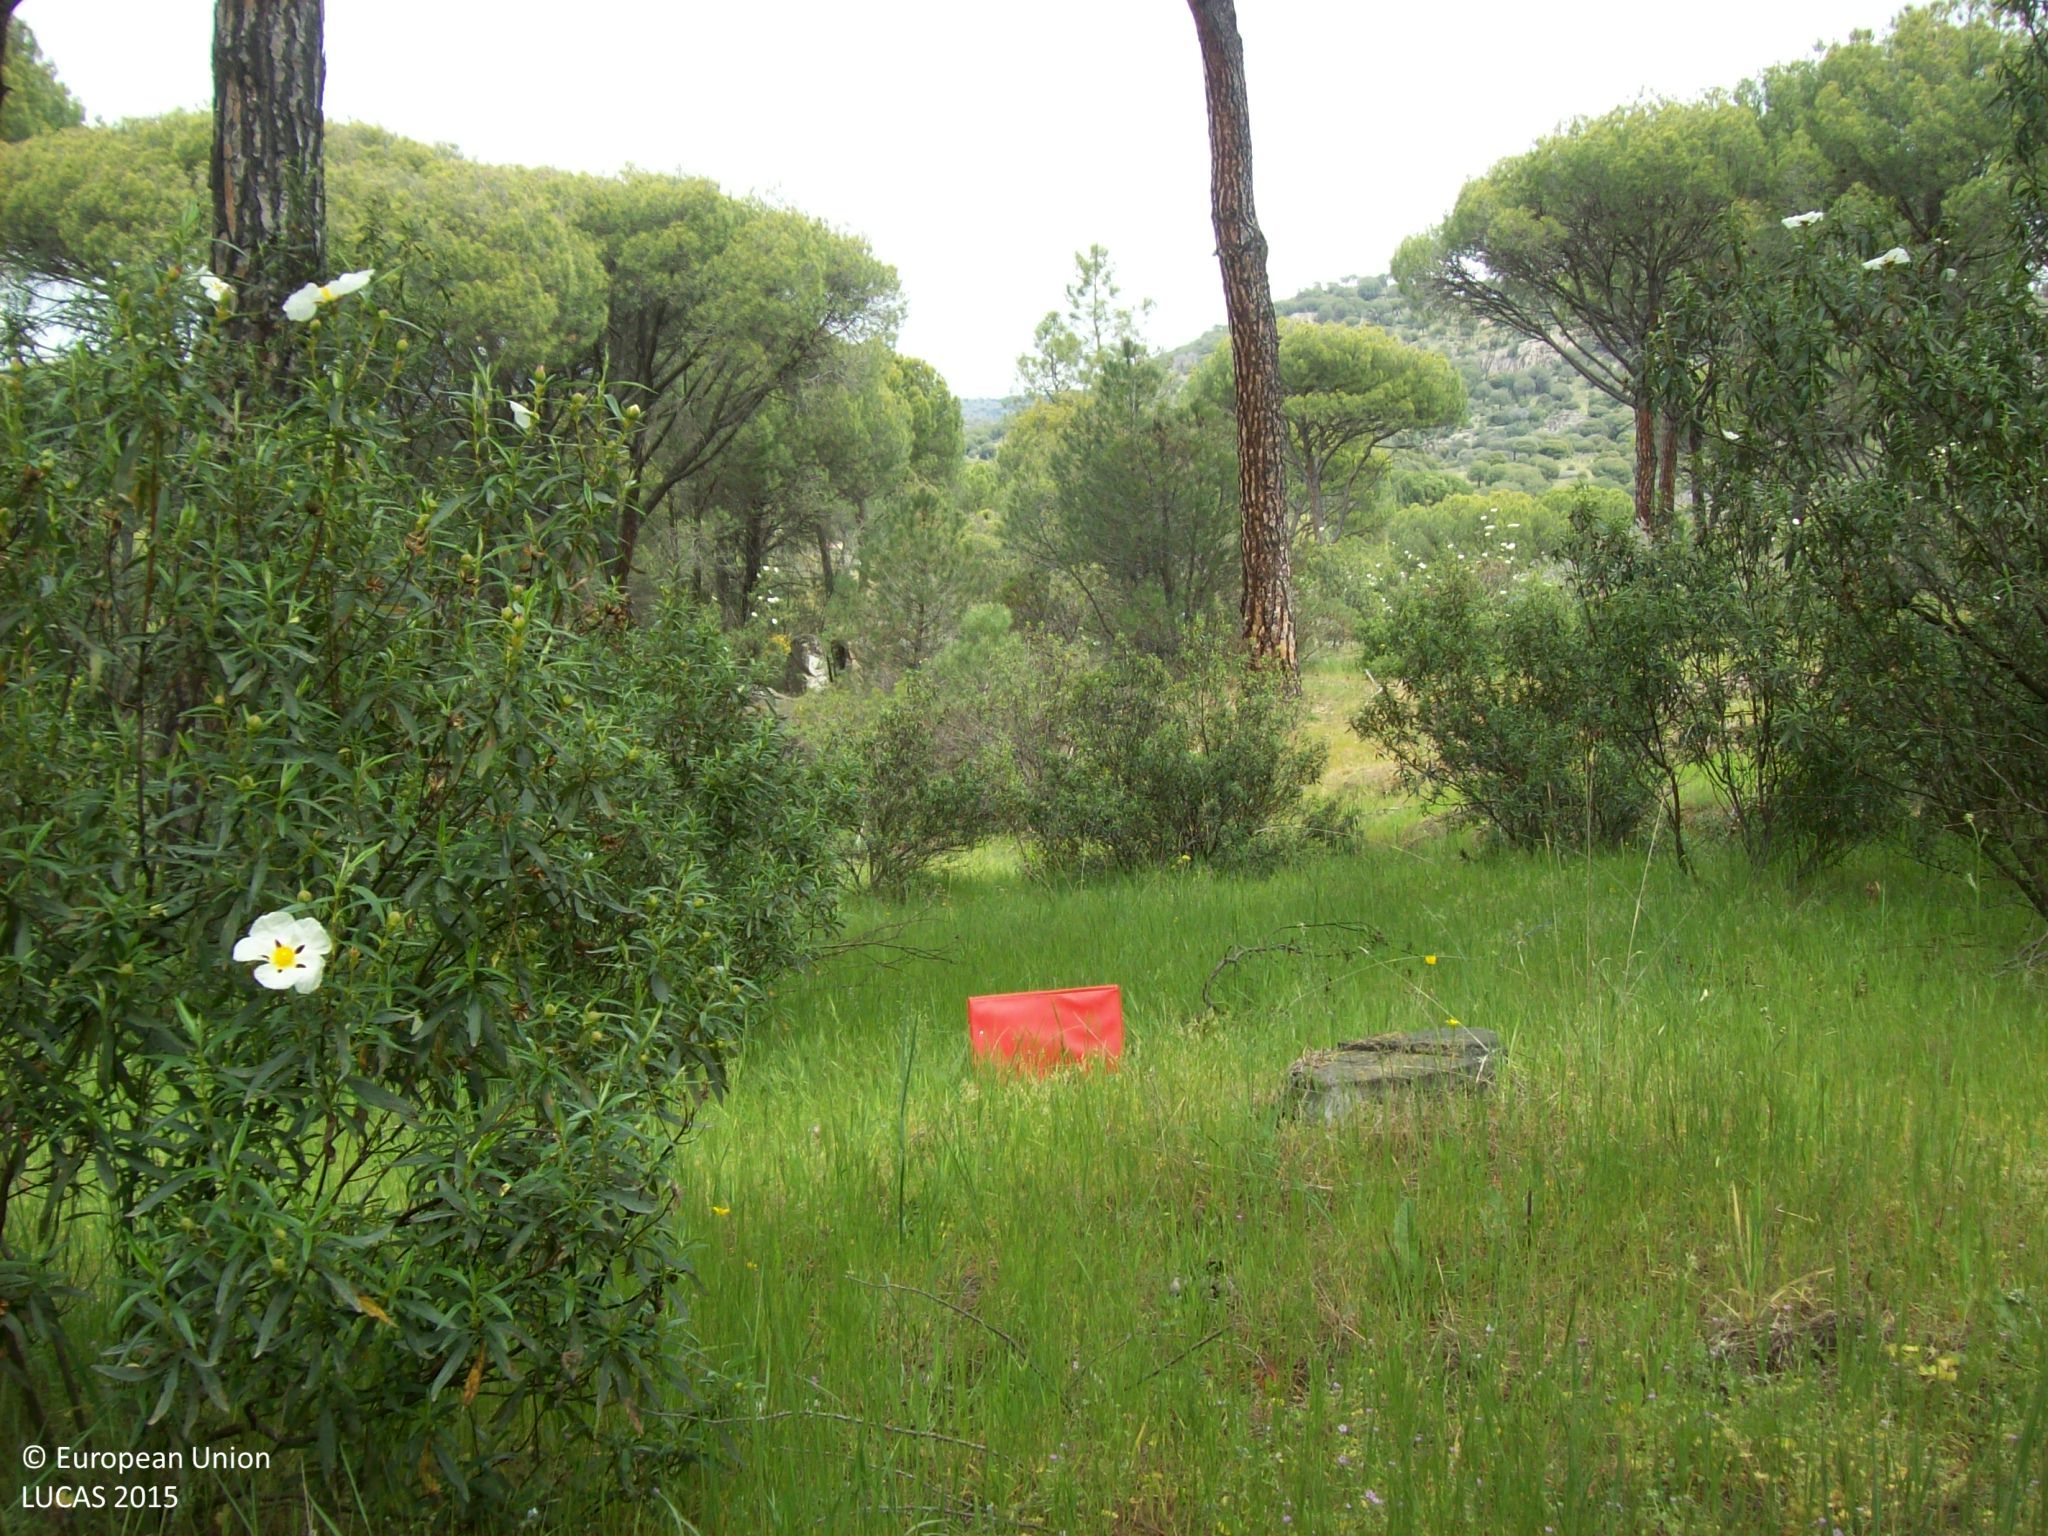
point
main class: Woodland
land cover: Pine dominated coniferous woodland
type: coniferous forest of the mediterranean region
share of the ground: > 75 %
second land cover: Grassland without tree/shrub cover
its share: > 75 %
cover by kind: coniferous forest trees 70 %, herbaceous plants 20 %, shrubs 5 %, consolidated bare surface 5 %
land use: Forestry
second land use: Agriculture (excluding fallow land and kitchen gardens)
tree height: > 5 m
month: April
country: ES
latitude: 40.4643
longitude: -4.4009
